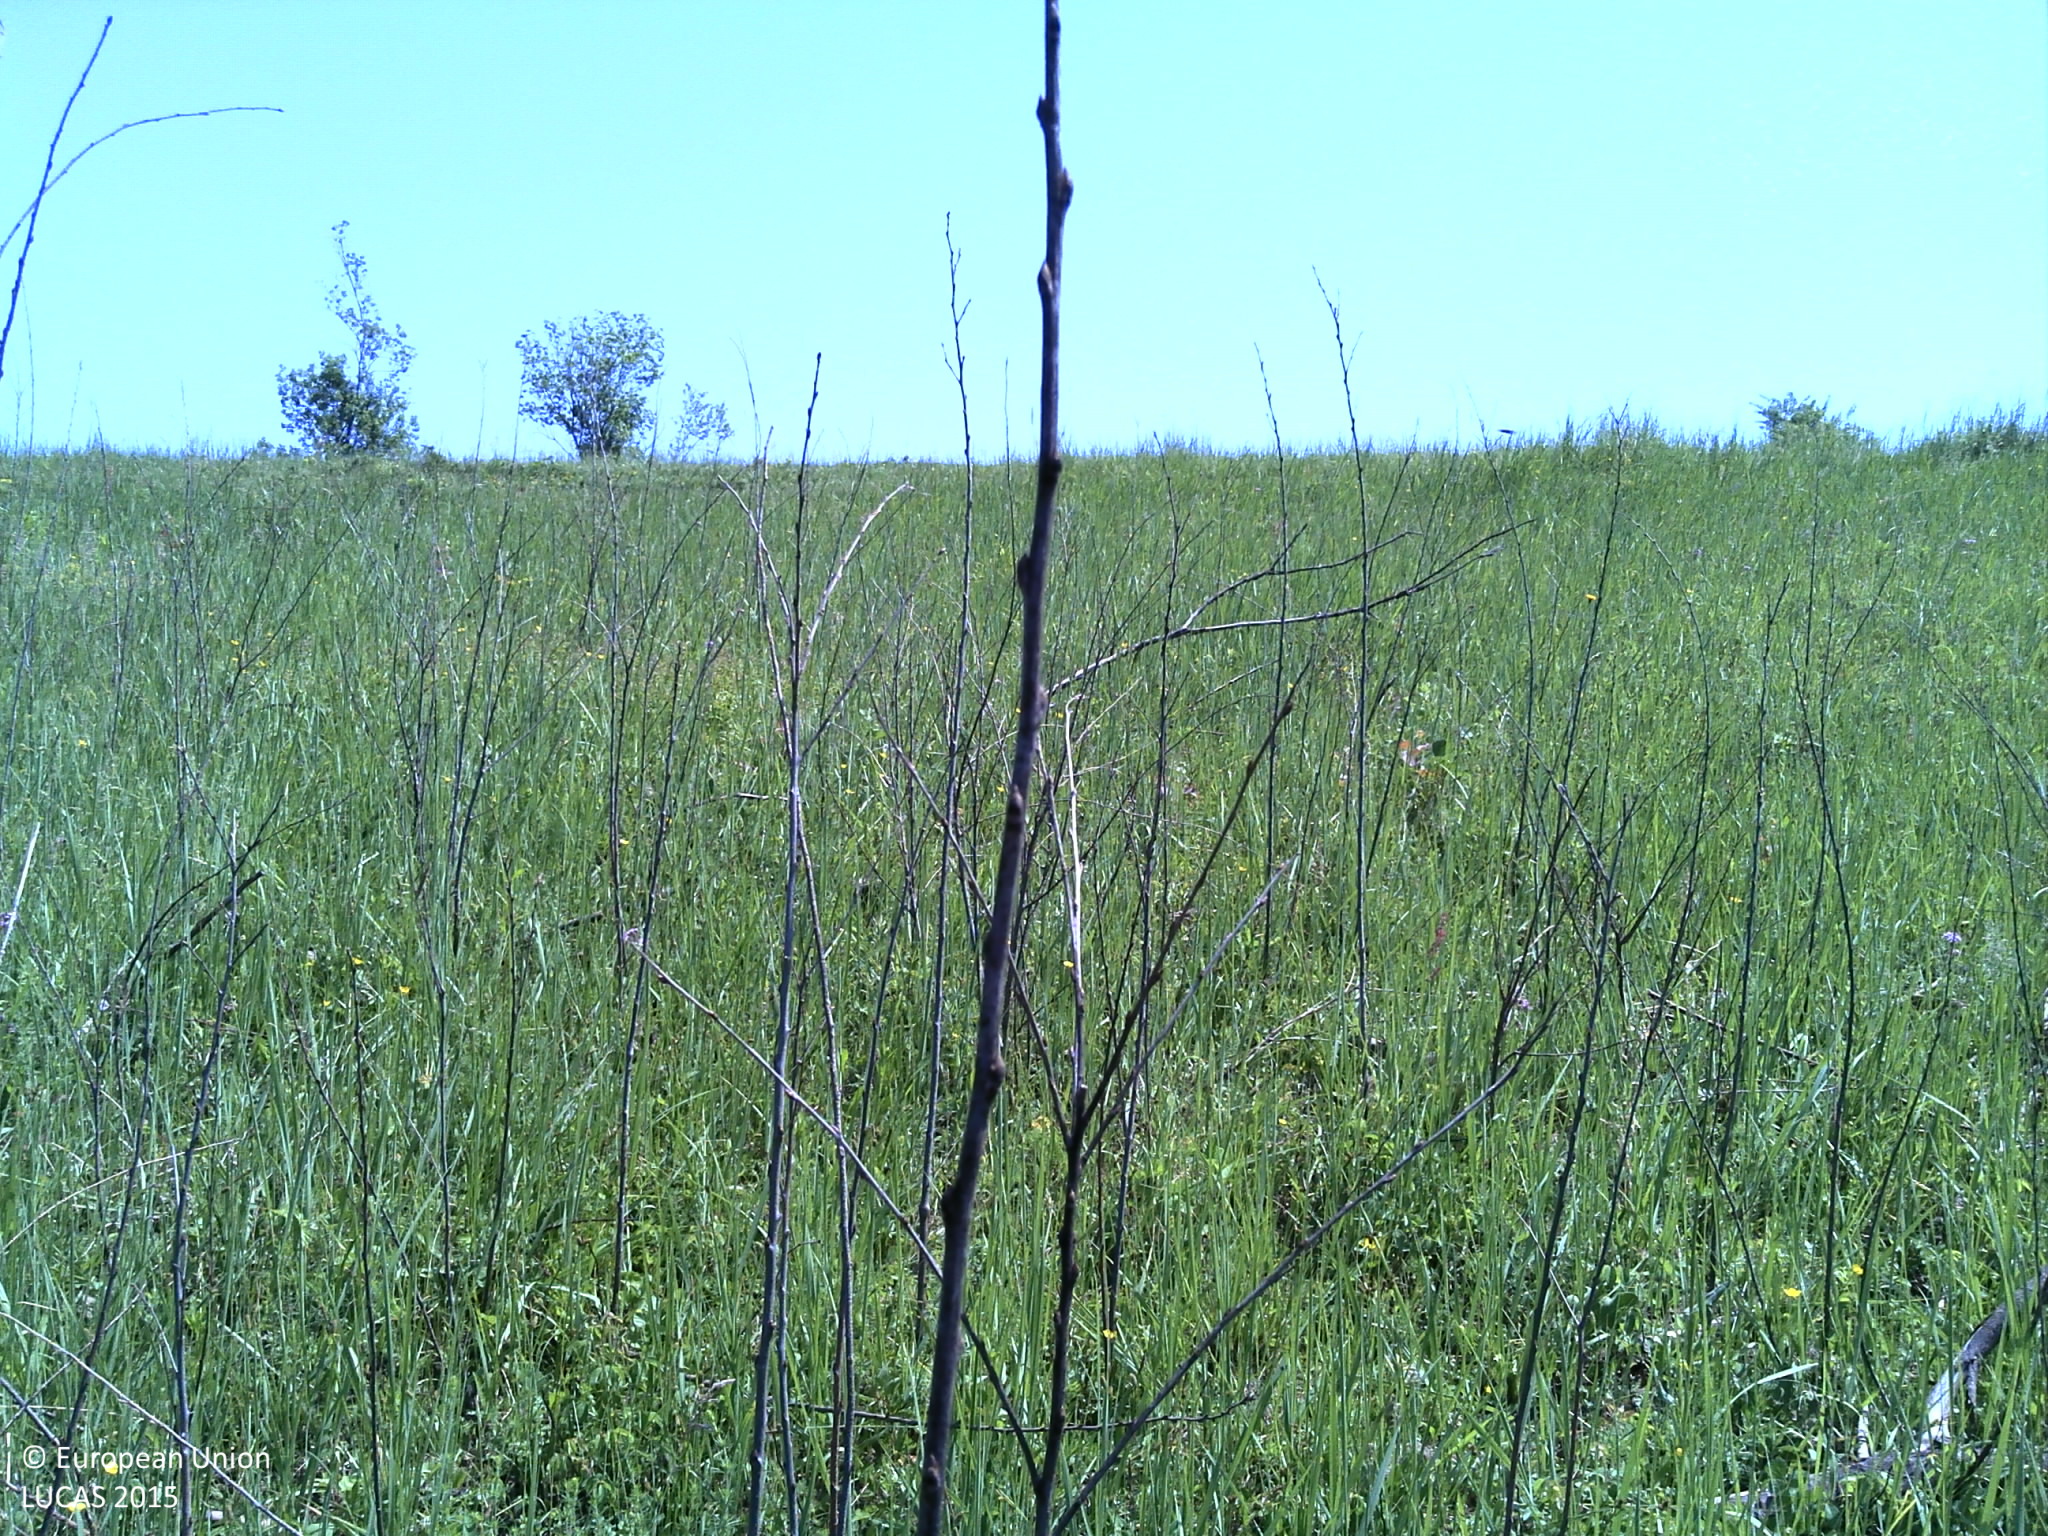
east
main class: Grassland
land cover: Spontaneously vegetated surfaces
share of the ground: > 75 %
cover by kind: herbaceous plants 95 %, shrubs 5 %
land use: Semi-natural and natural areas not in use
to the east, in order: Spontaneously vegetated surfaces; Tracks; Grassland without tree/shrub cover; Tracks; Grassland without tree/shrub cover; Common wheat
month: May
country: HR
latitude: 45.3909
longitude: 18.1147
